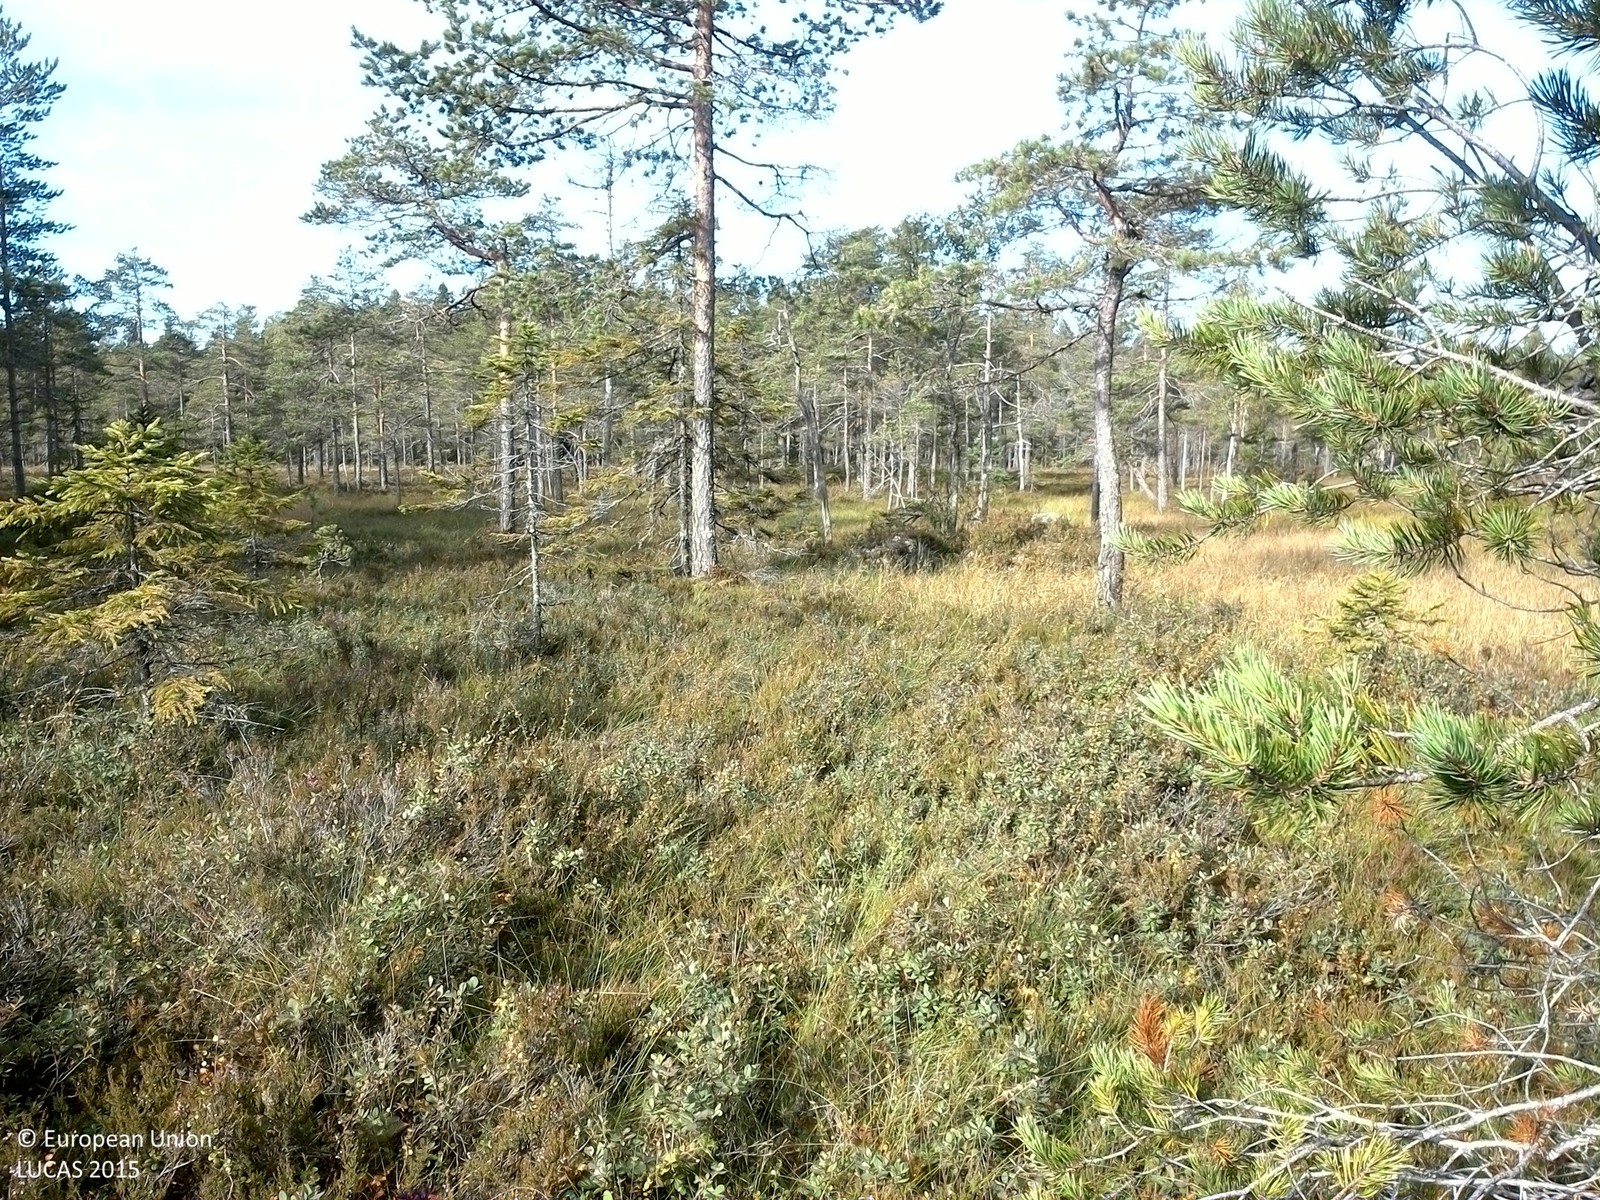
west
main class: Woodland
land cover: Pine dominated coniferous woodland
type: boreal forest
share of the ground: 25 - 50 %
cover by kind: coniferous forest trees 40 %, shrubs 25 %, lichens and mosses 20 %, broadleaved forest trees 10 %, herbaceous plants 5 %
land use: Forestry
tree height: < 5 m
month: September
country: SE
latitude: 59.9601
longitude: 13.3758
